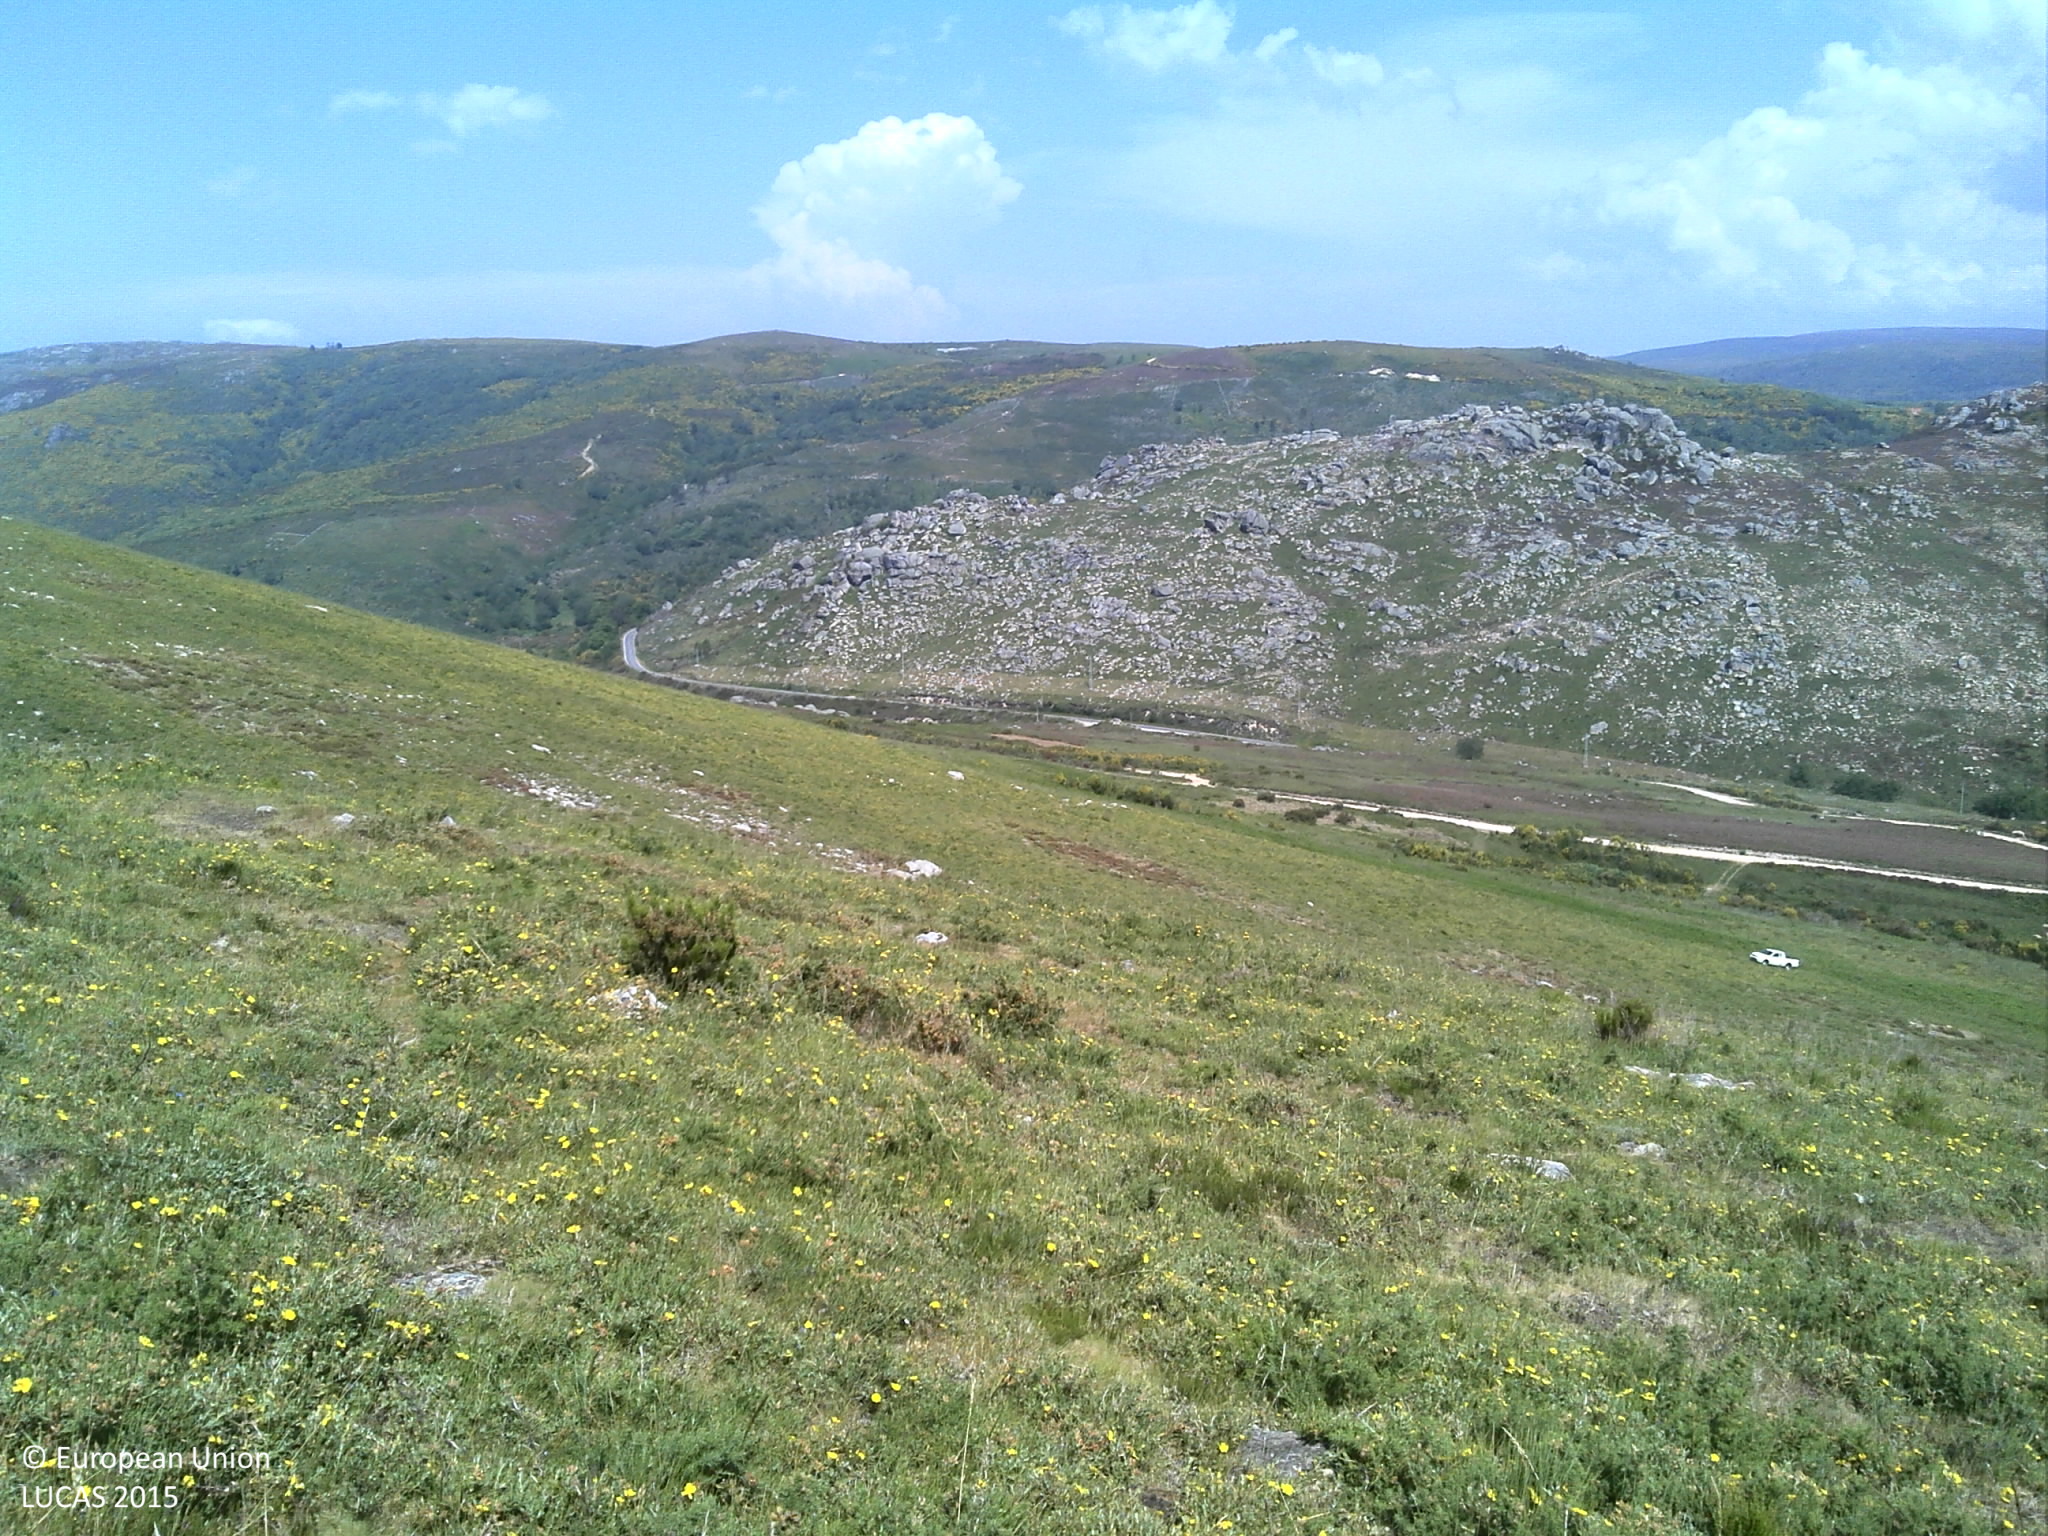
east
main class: Shrubland
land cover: Shrubland without tree cover
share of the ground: 50 - 75 %
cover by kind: shrubs 80 %, herbaceous plants 20 %
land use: Agriculture (excluding fallow land and kitchen gardens)
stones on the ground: 10 - 25 %
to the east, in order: Shrubland without tree cover; Spontaneously vegetated surfaces
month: June
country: PT
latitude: 42.0602
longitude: -8.1970
